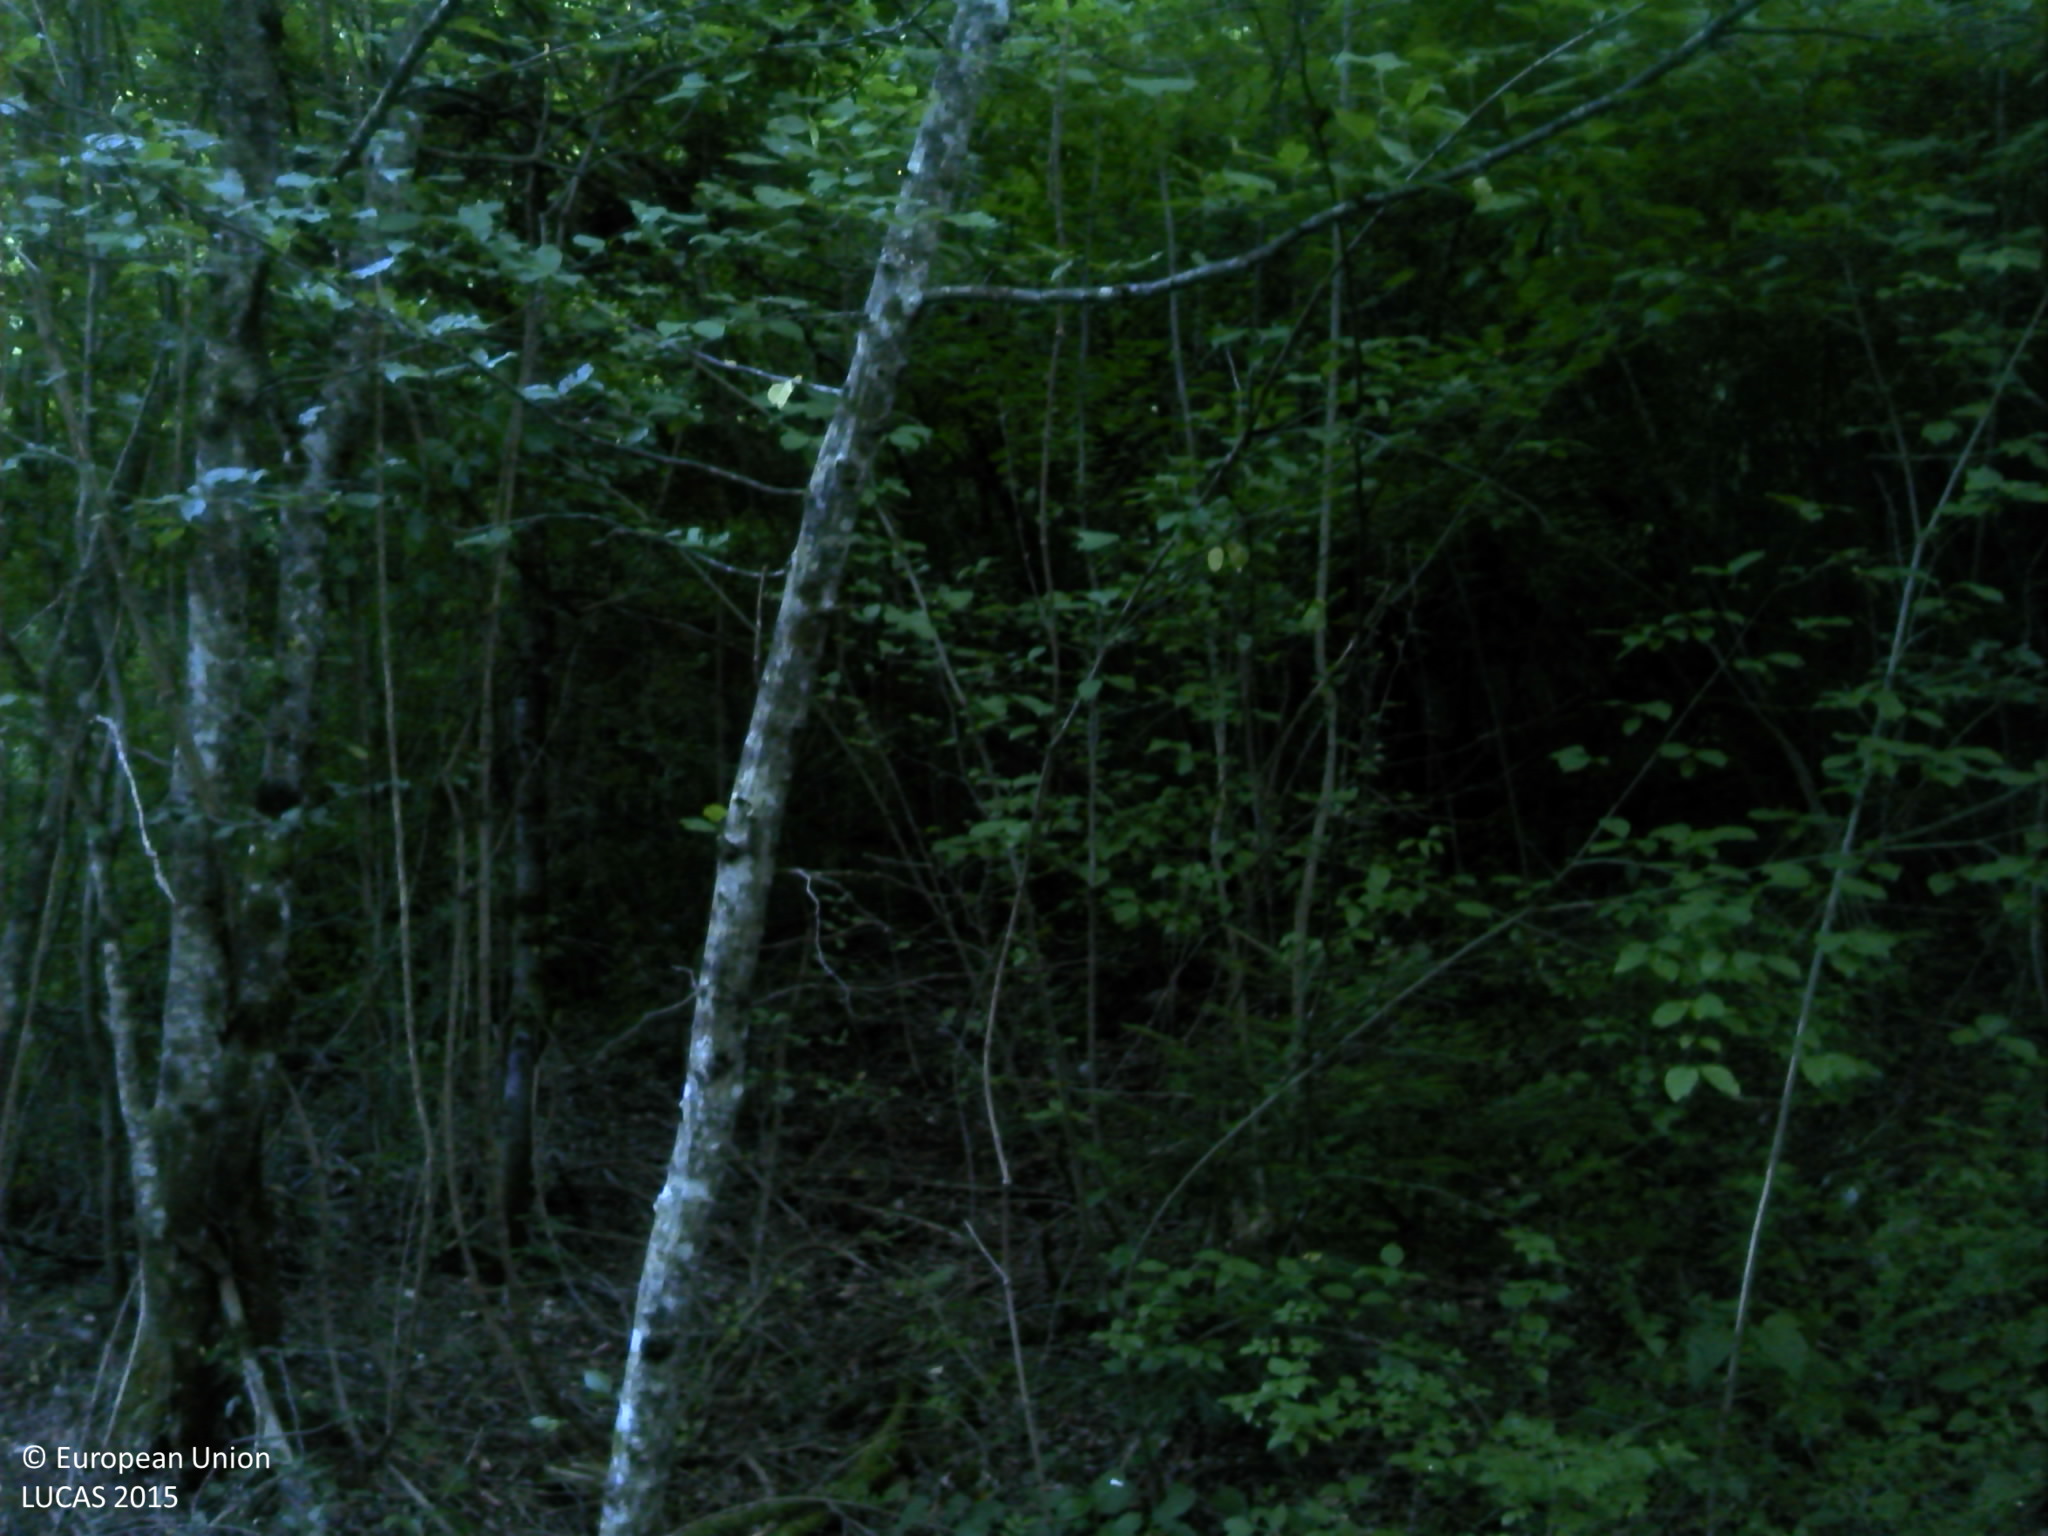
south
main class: Woodland
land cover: Broadleaved woodland
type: beech forest
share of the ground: > 75 %
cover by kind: broadleaved forest trees 90 %, shrubs 10 %
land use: Semi-natural and natural areas not in use
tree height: > 5 m
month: July
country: HR
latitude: 45.0313
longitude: 15.2368
